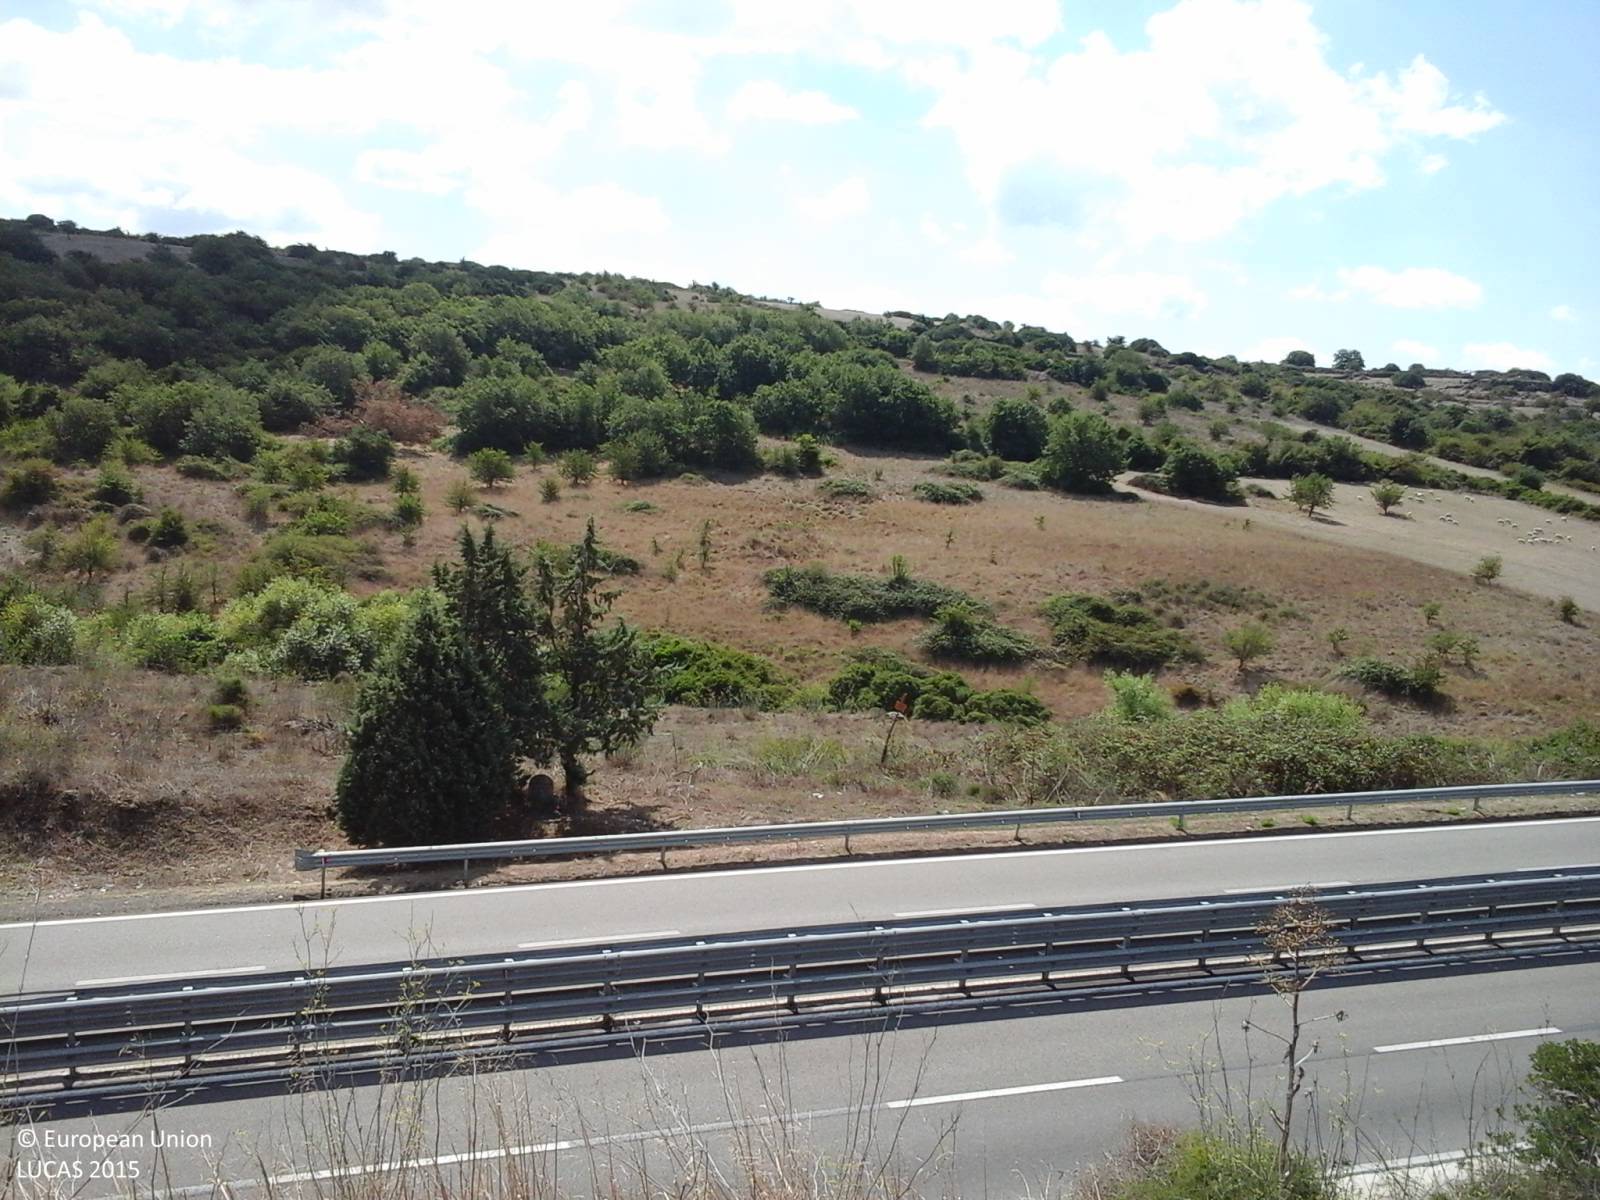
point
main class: Grassland
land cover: Grassland without tree/shrub cover
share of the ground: > 75 %
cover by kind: herbaceous plants 100 %
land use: Agriculture (excluding fallow land and kitchen gardens)
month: August
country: IT
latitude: 40.1341
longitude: 8.8676
